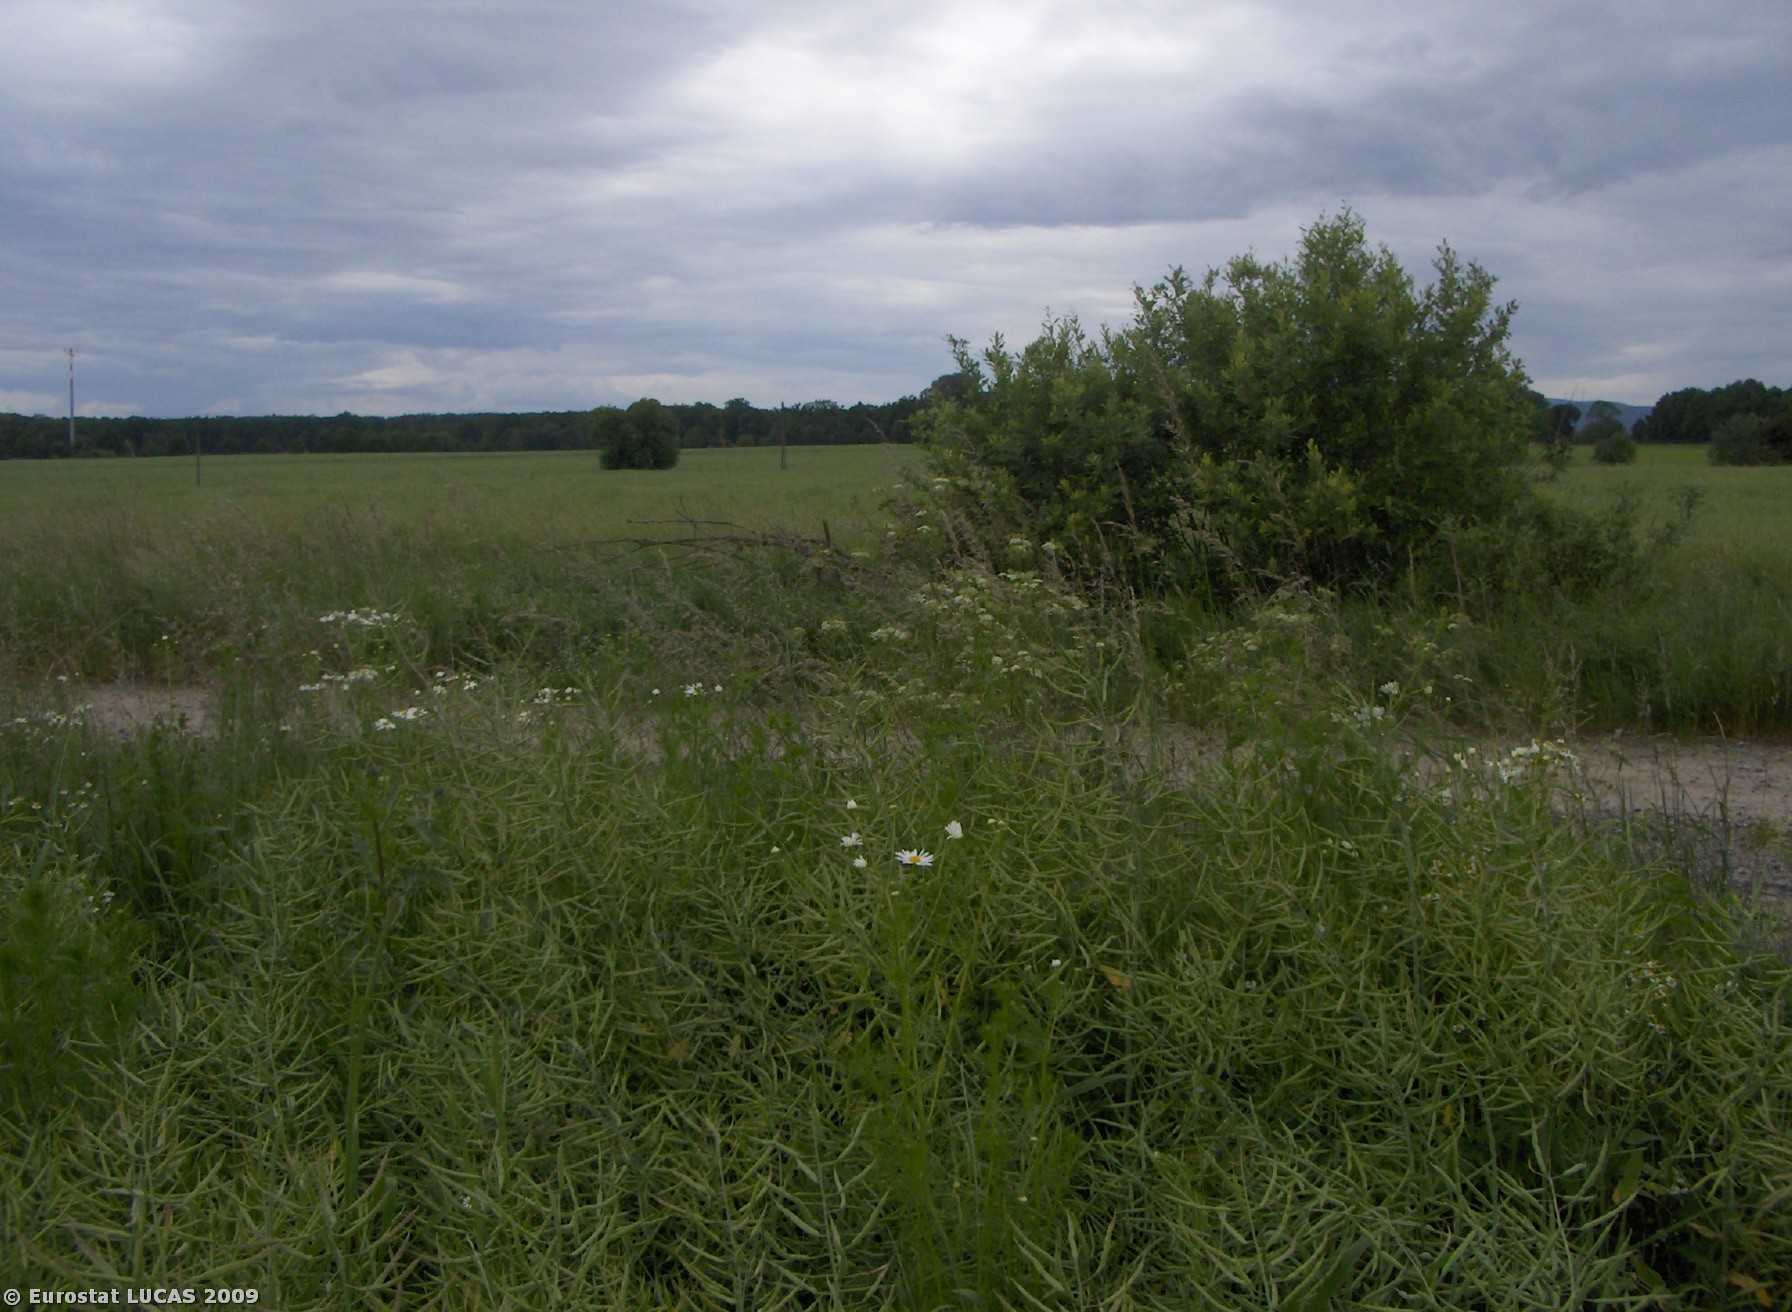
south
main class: Cropland
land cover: Rape and turnip rape
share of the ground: > 75 %
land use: Agriculture (excluding fallow land and kitchen gardens)
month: June
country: CZ
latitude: 49.0391
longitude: 14.3373
